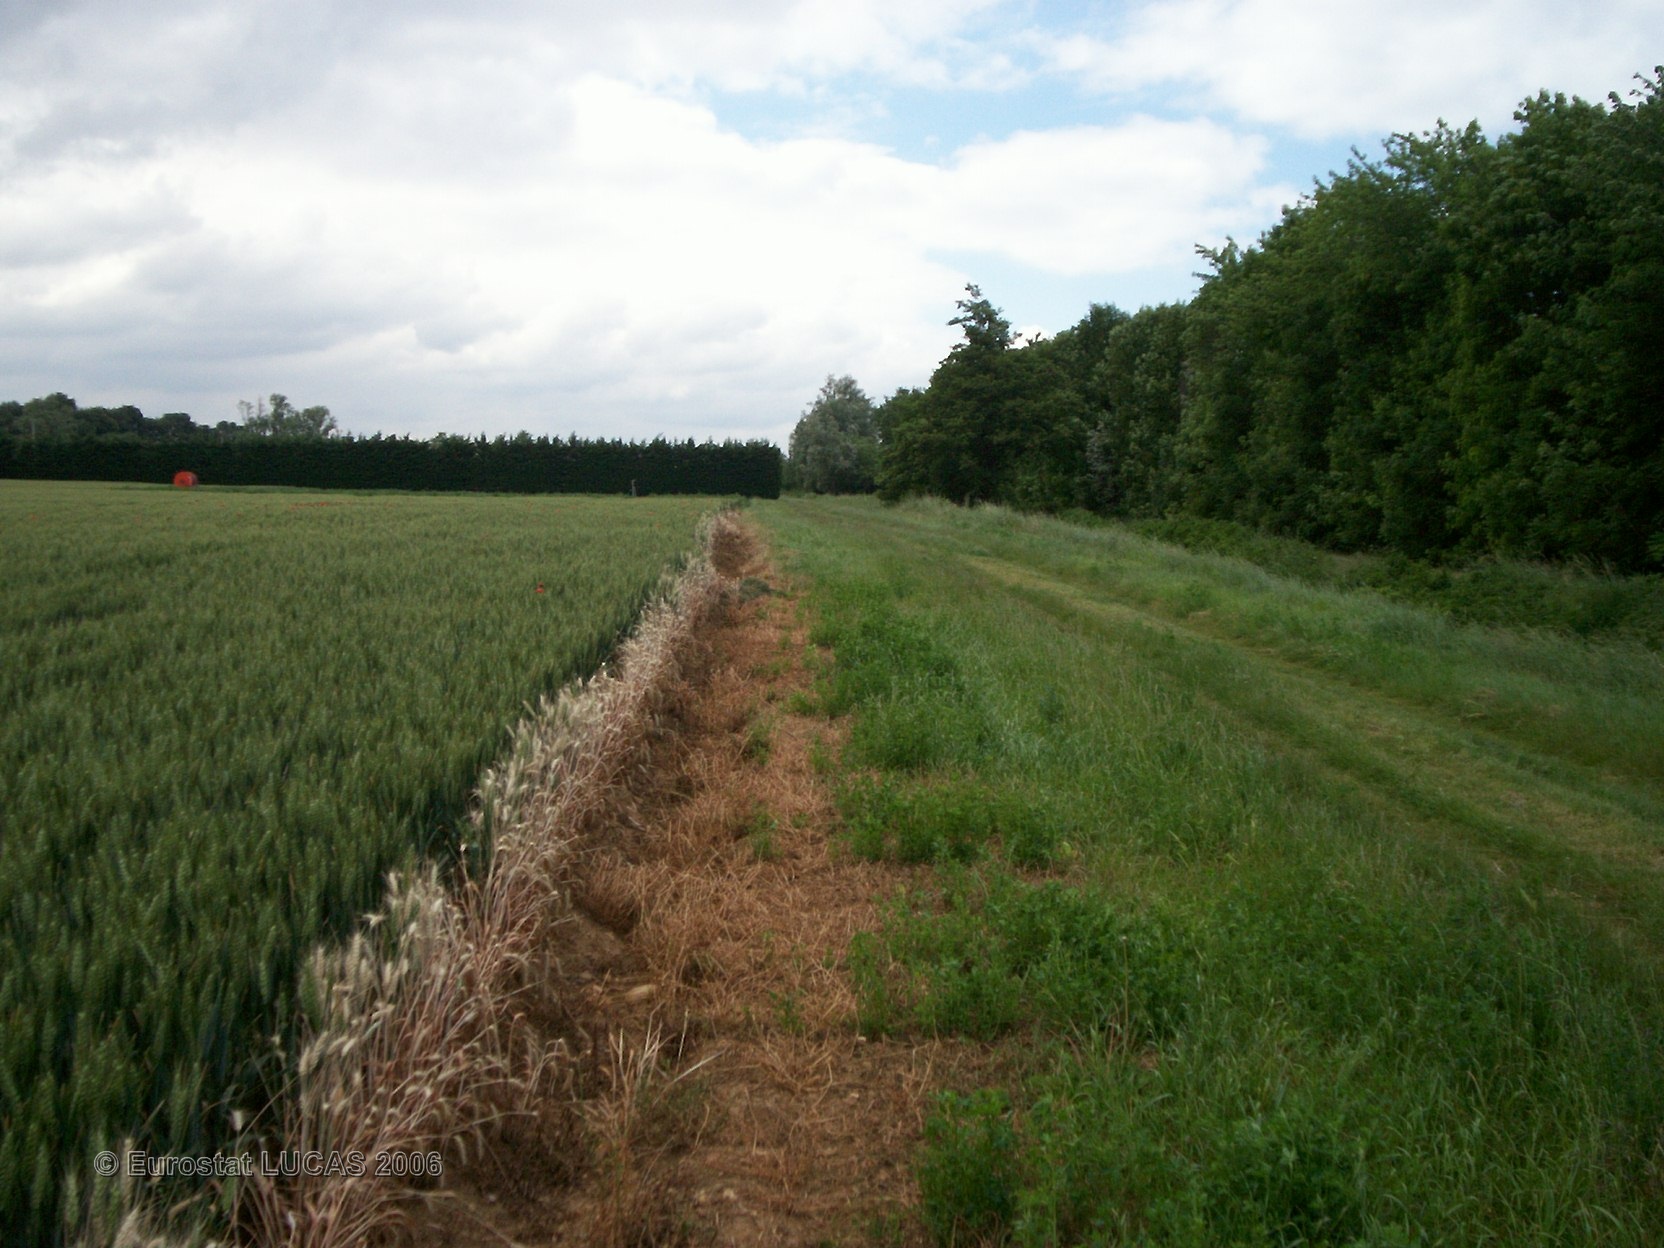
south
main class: Grassland
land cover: Grassland without tree/shrub cover
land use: Agriculture (excluding fallow land and kitchen gardens)
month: June
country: FR
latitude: 44.8206
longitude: 4.8842
